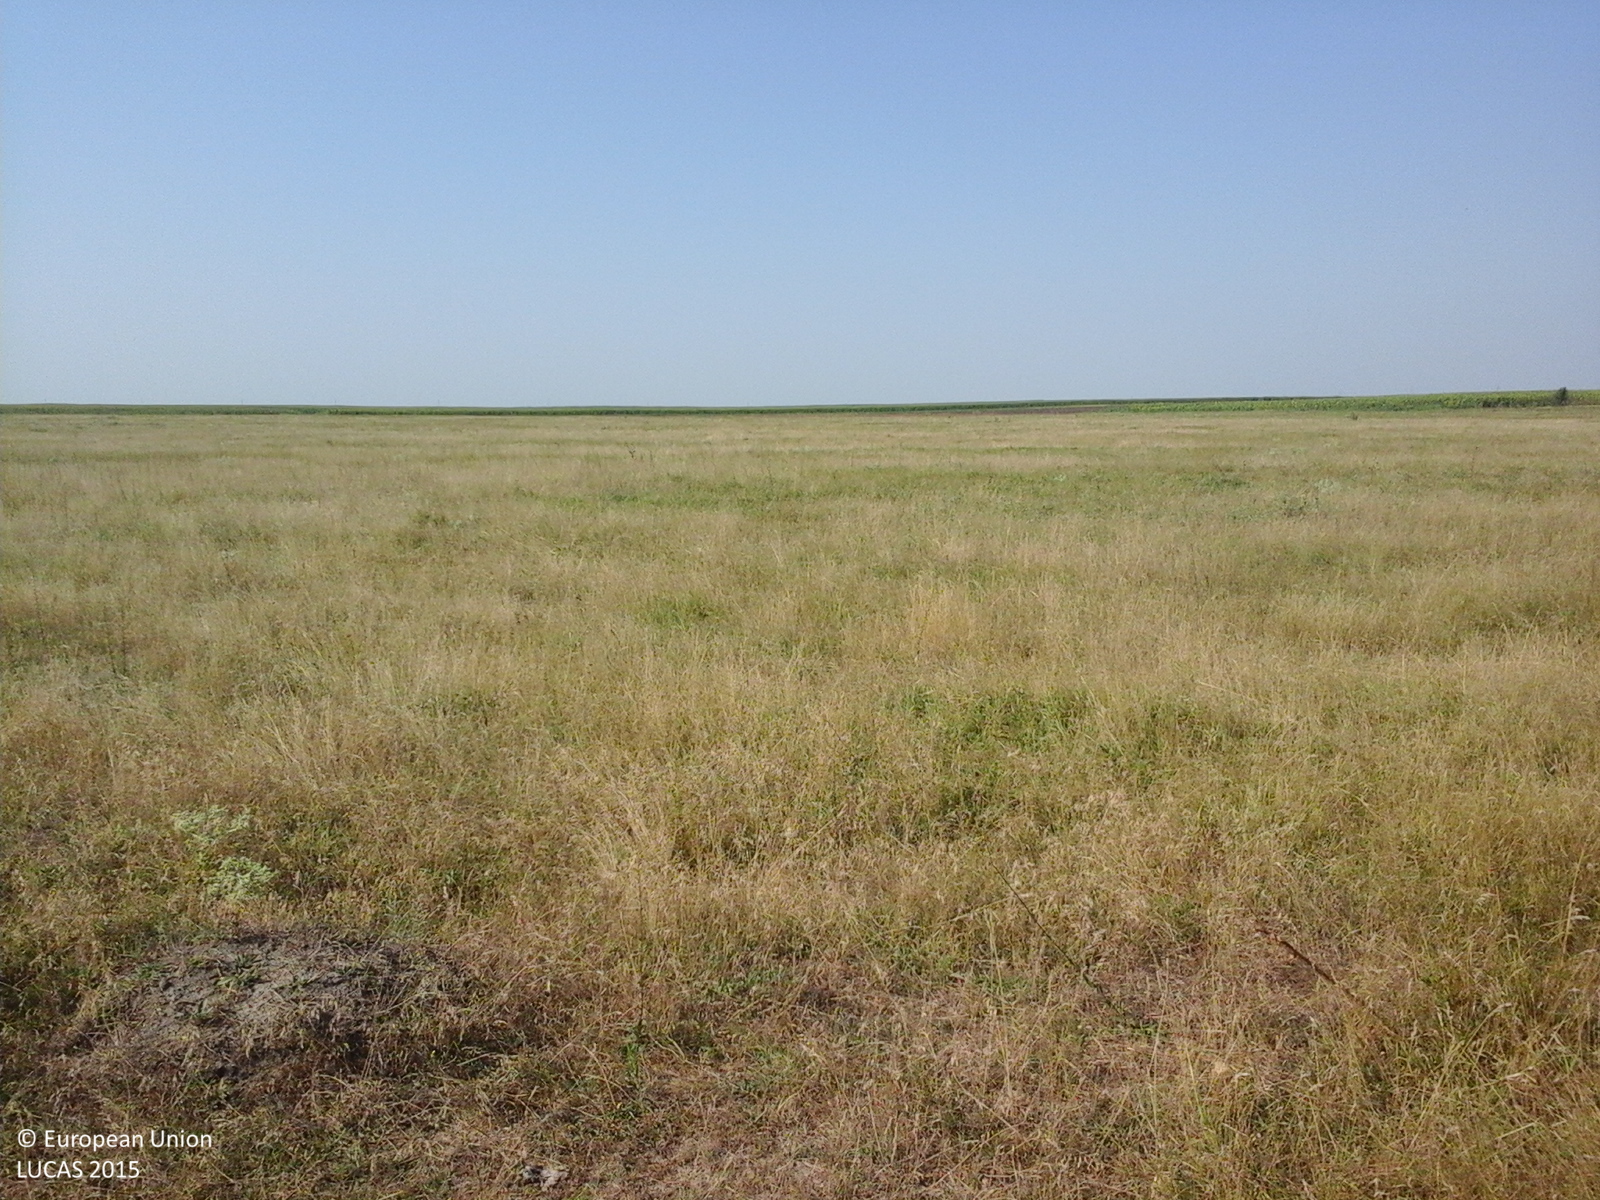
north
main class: Grassland
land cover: Grassland without tree/shrub cover
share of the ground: > 75 %
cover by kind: herbaceous plants 100 %
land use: Agriculture (excluding fallow land and kitchen gardens)
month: July
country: RO
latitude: 44.8387
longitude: 27.2817
